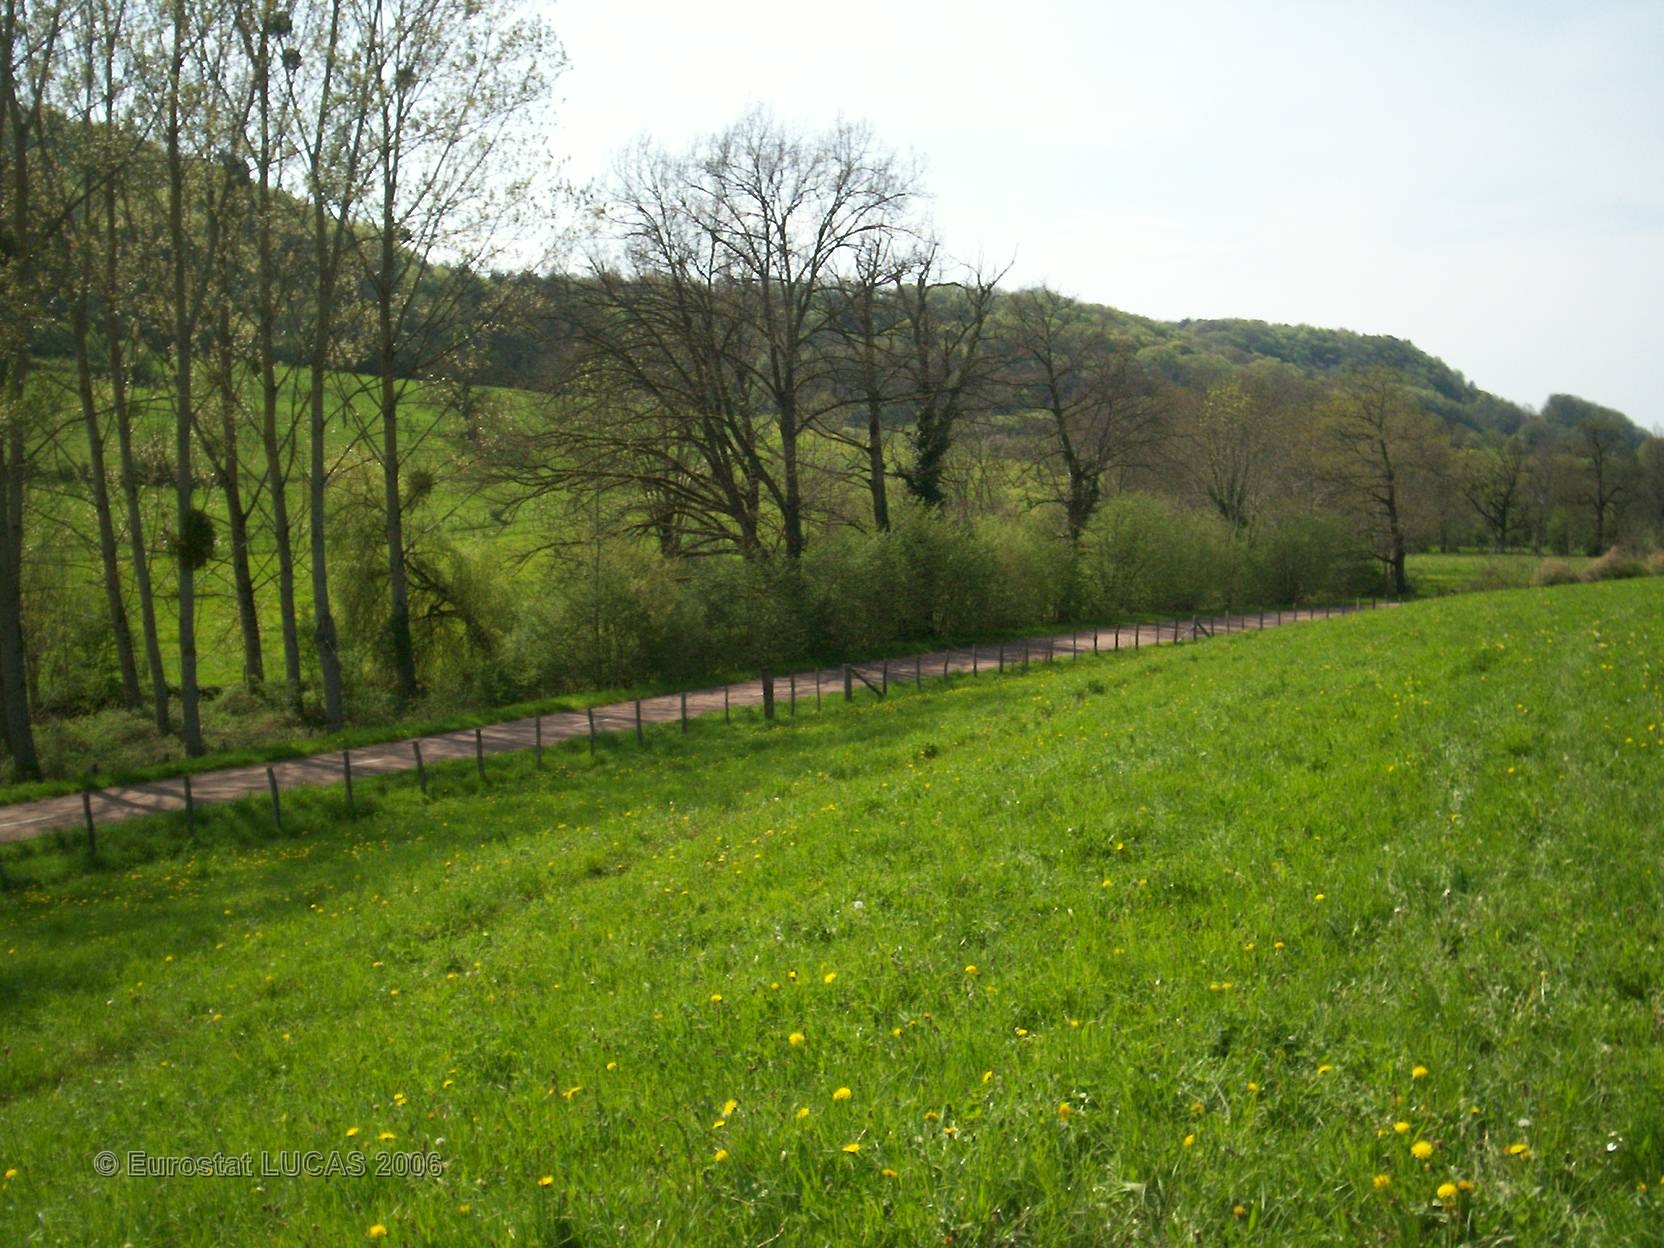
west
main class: Grassland
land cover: Grassland without tree/shrub cover
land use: Agriculture (excluding fallow land and kitchen gardens)
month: May
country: FR
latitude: 47.5331
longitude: 4.6195
